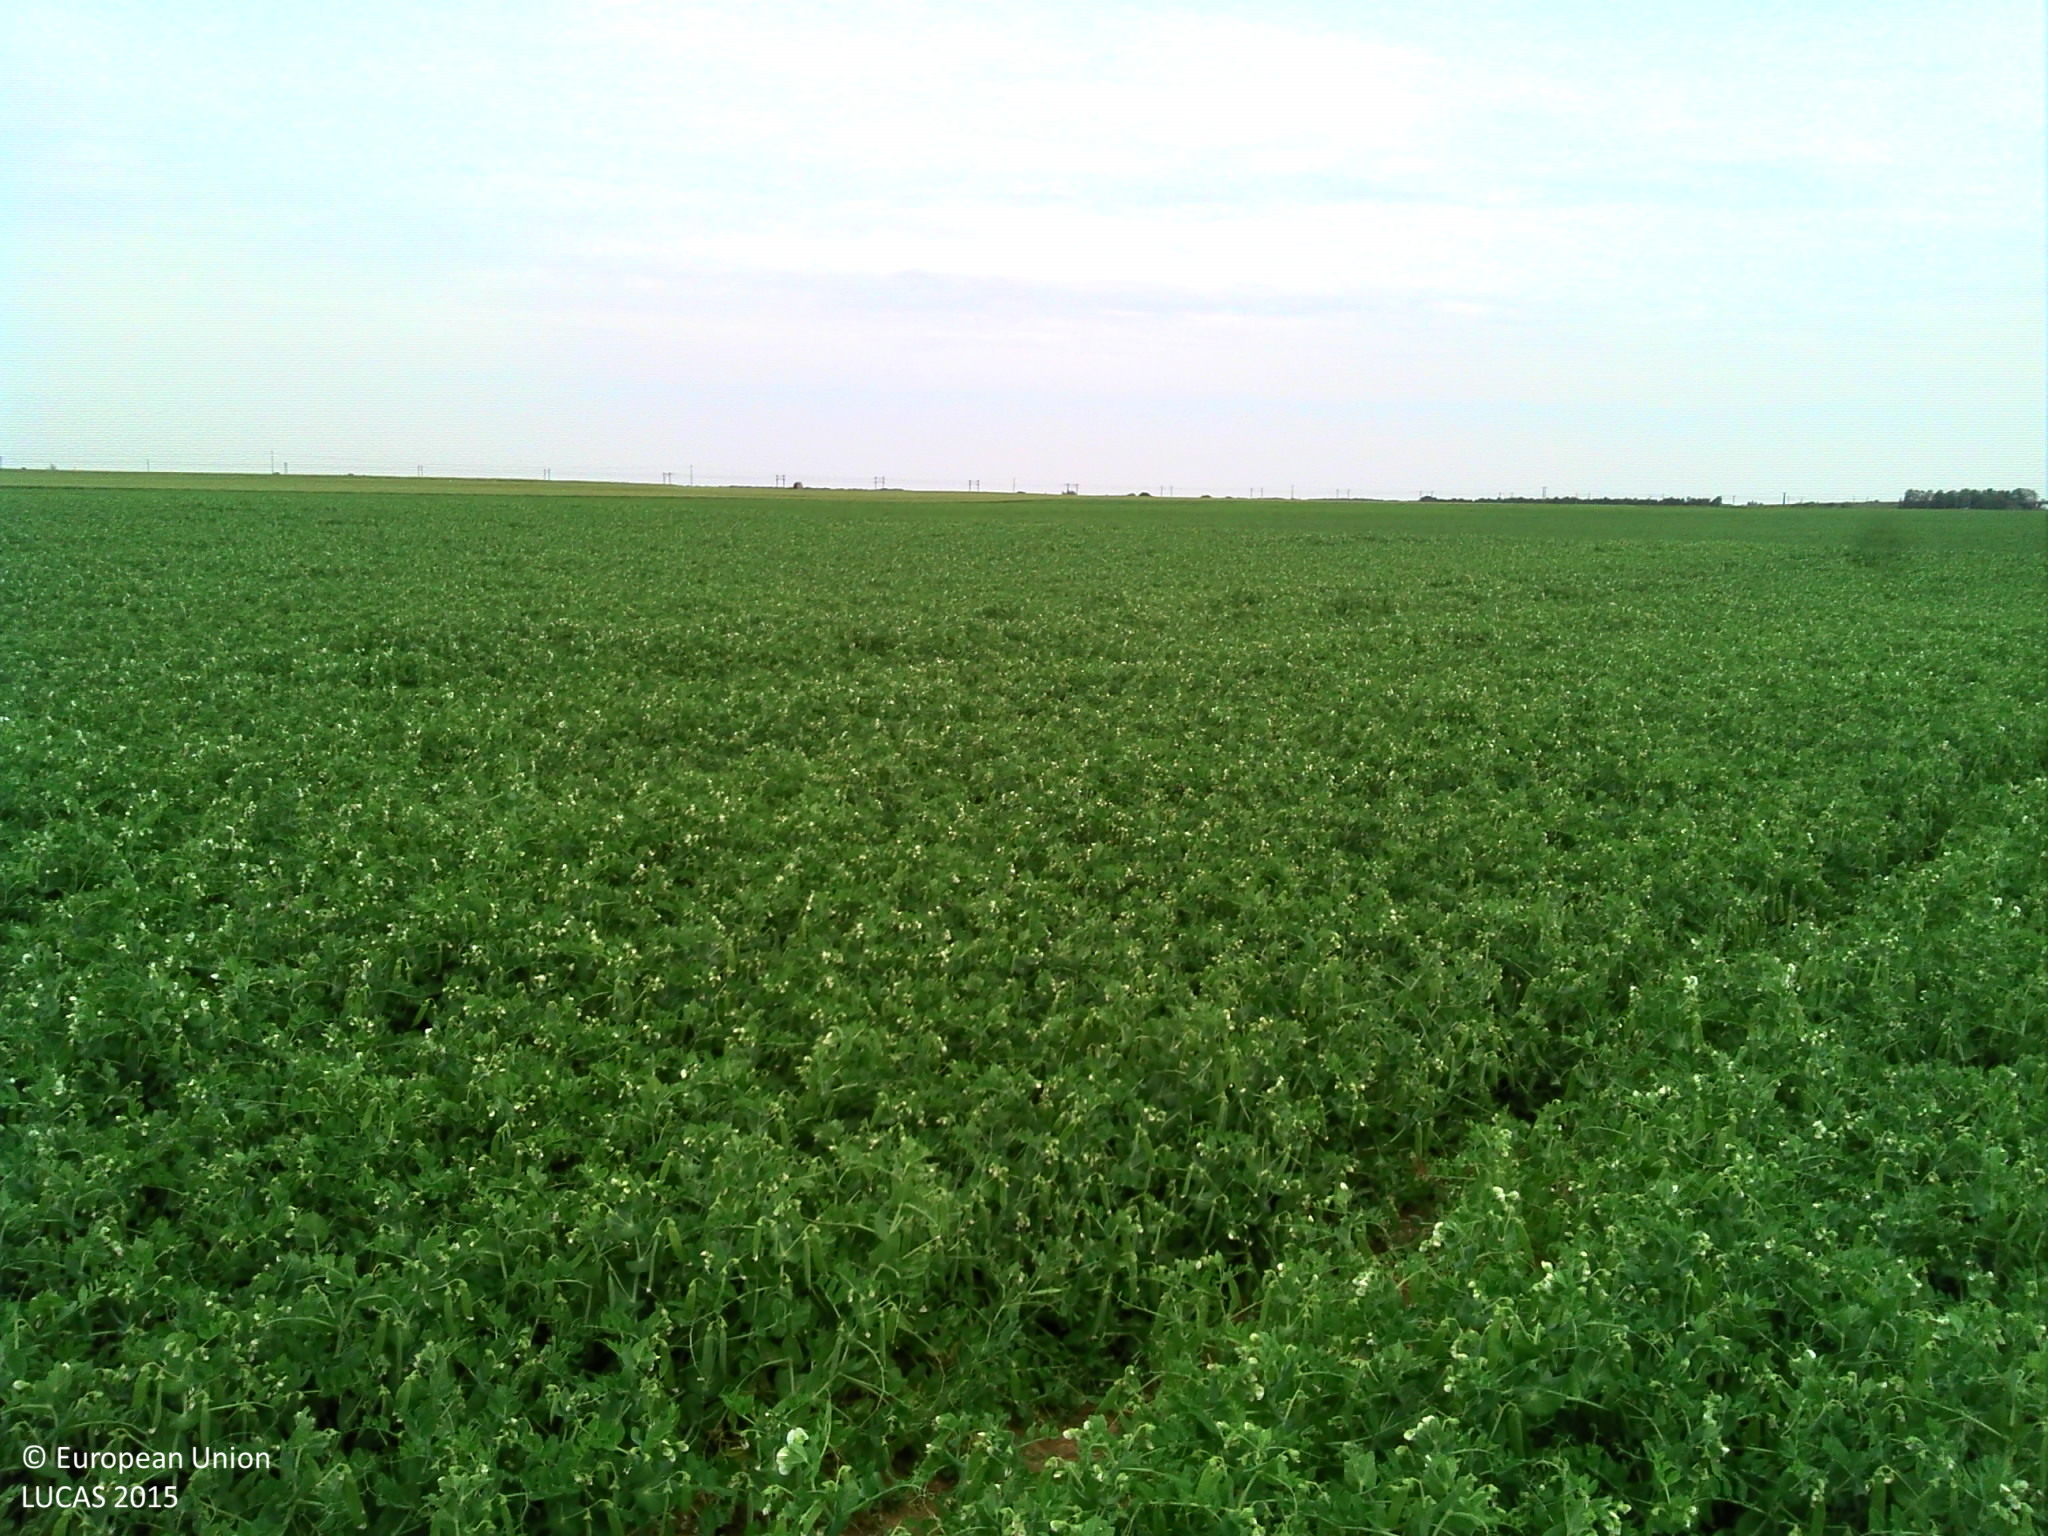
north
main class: Cropland
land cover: Dry pulses
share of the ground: > 75 %
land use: Agriculture (excluding fallow land and kitchen gardens)
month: June
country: FR
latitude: 48.2177
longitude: 1.4640
